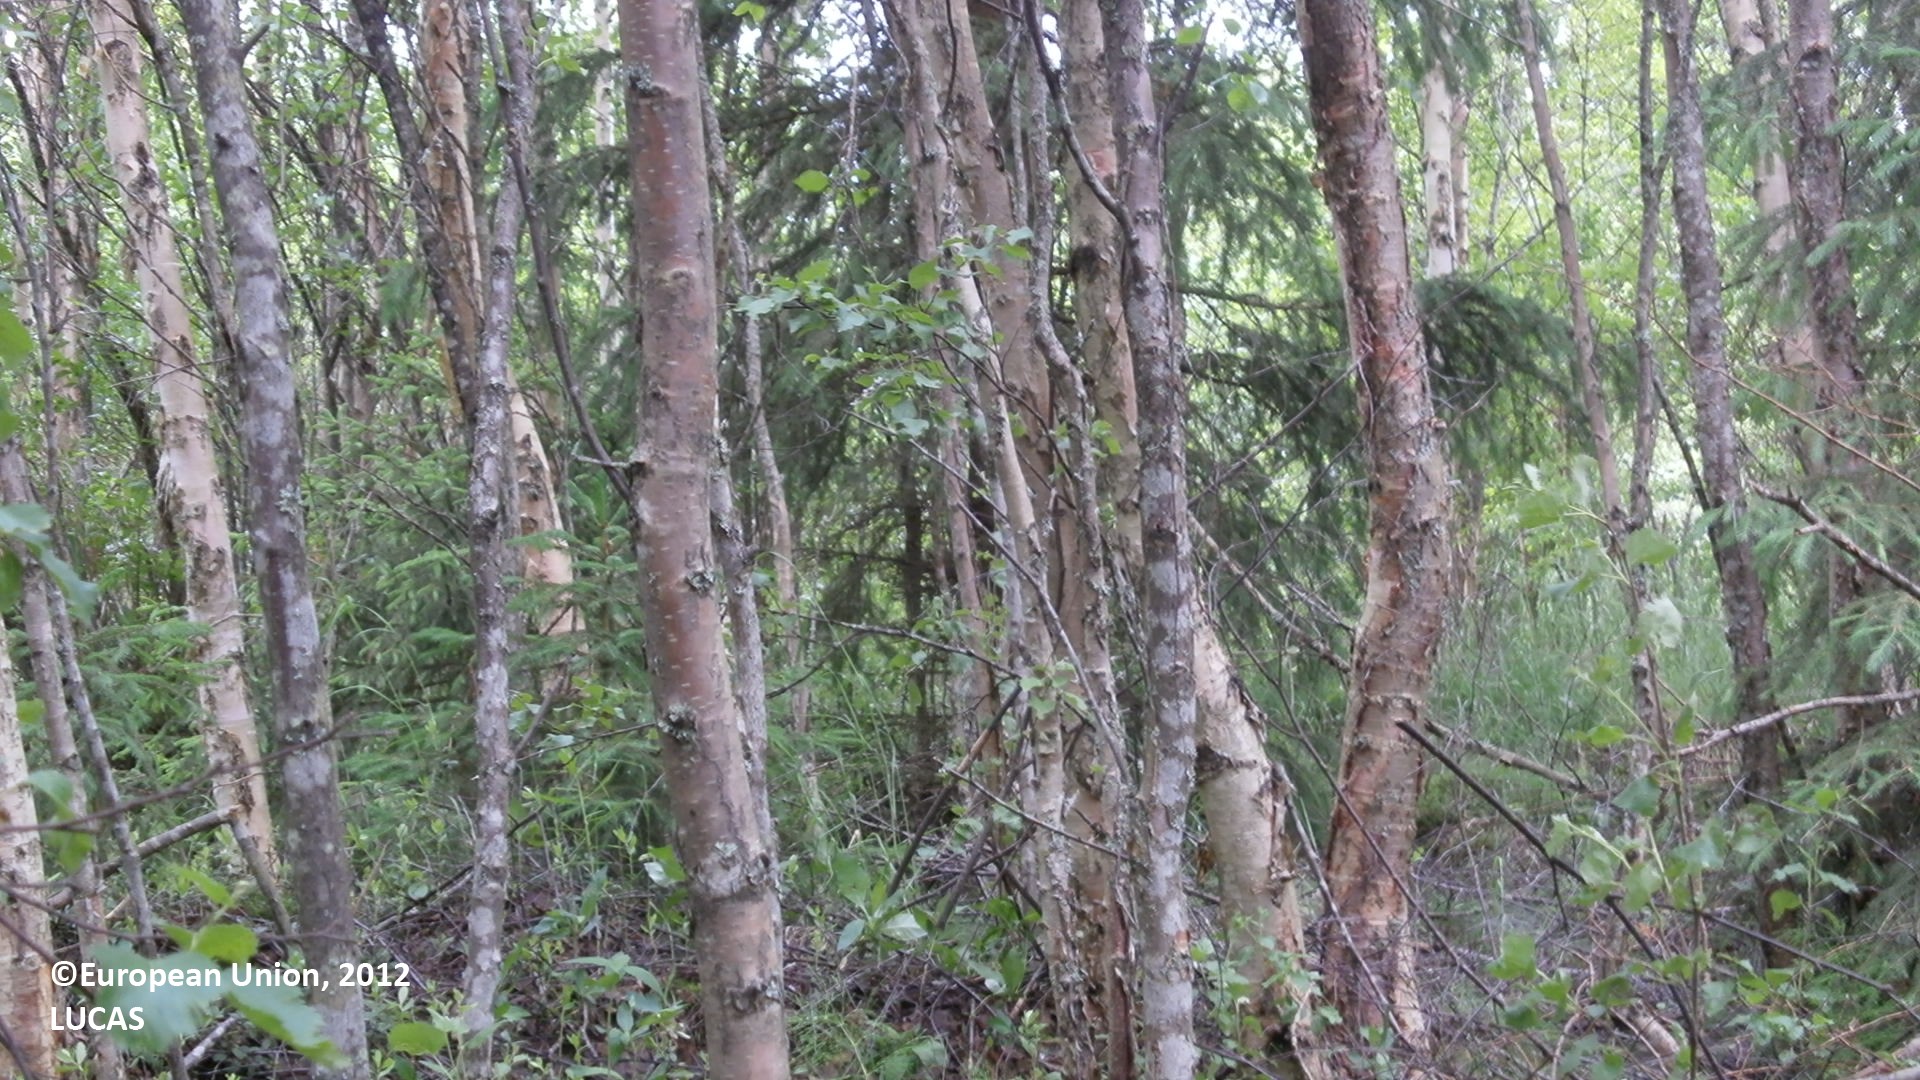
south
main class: Woodland
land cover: Broadleaved woodland
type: boreal forest
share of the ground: > 75 %
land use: Forestry
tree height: > 5 m
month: June
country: FI
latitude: 64.6067
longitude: 25.1499
